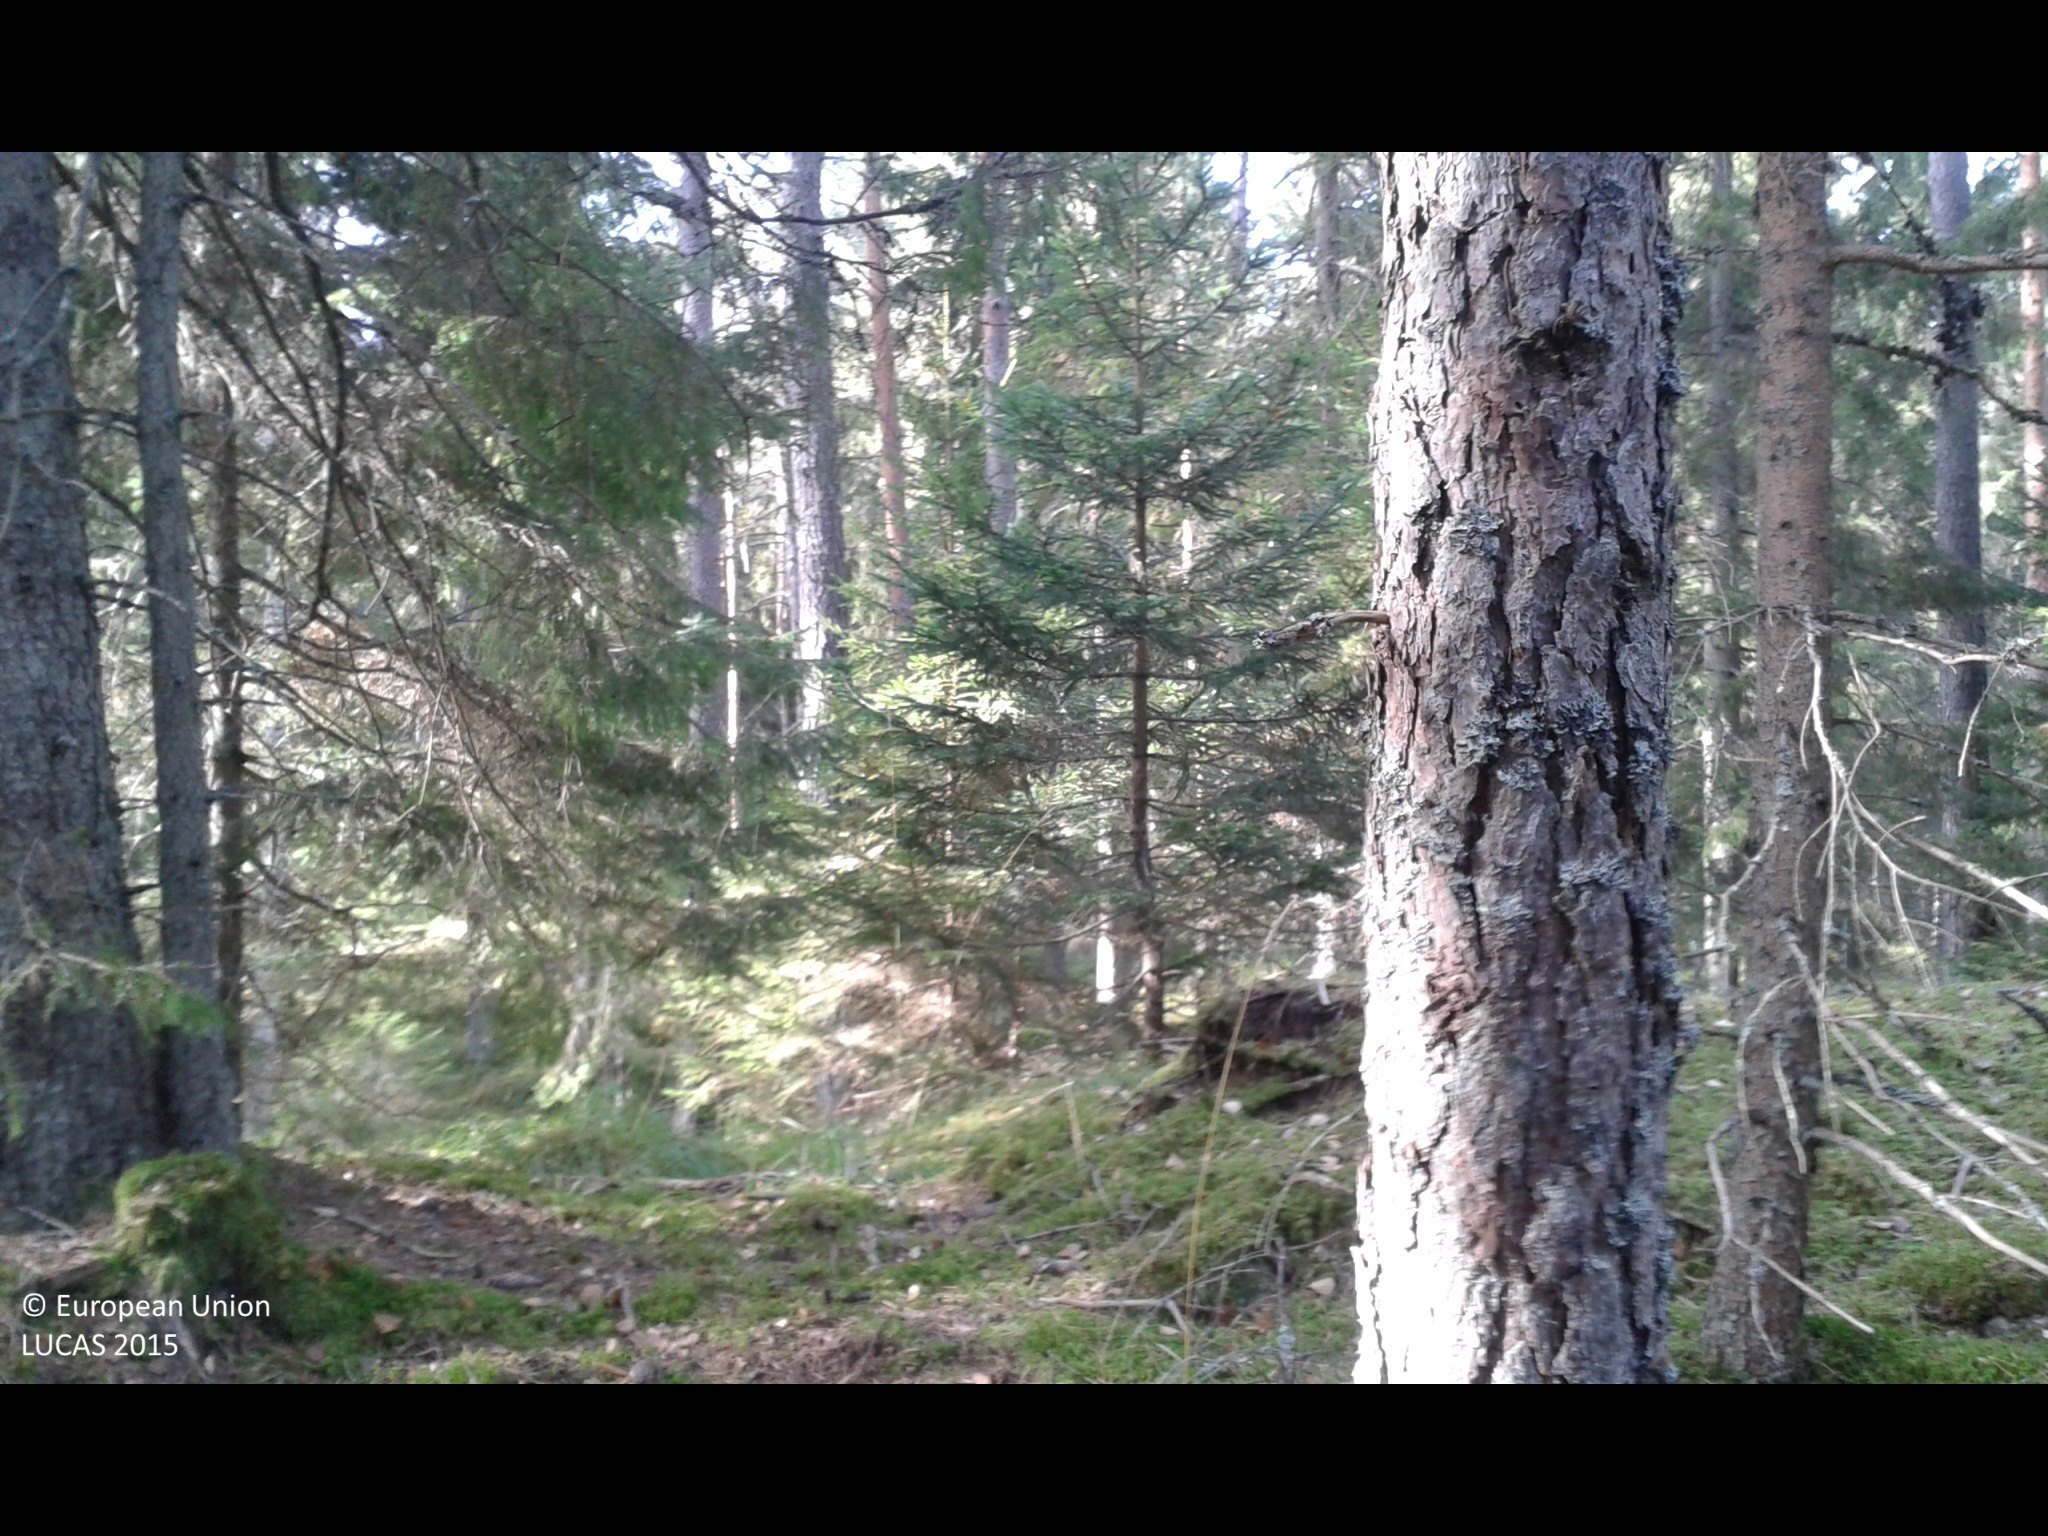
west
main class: Woodland
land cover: Spruce dominated coniferous woodland
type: boreal forest
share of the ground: > 75 %
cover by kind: coniferous forest trees 80 %, herbaceous plants 20 %
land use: Forestry
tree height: > 5 m
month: October
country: SE
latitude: 58.9186
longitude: 17.4130
